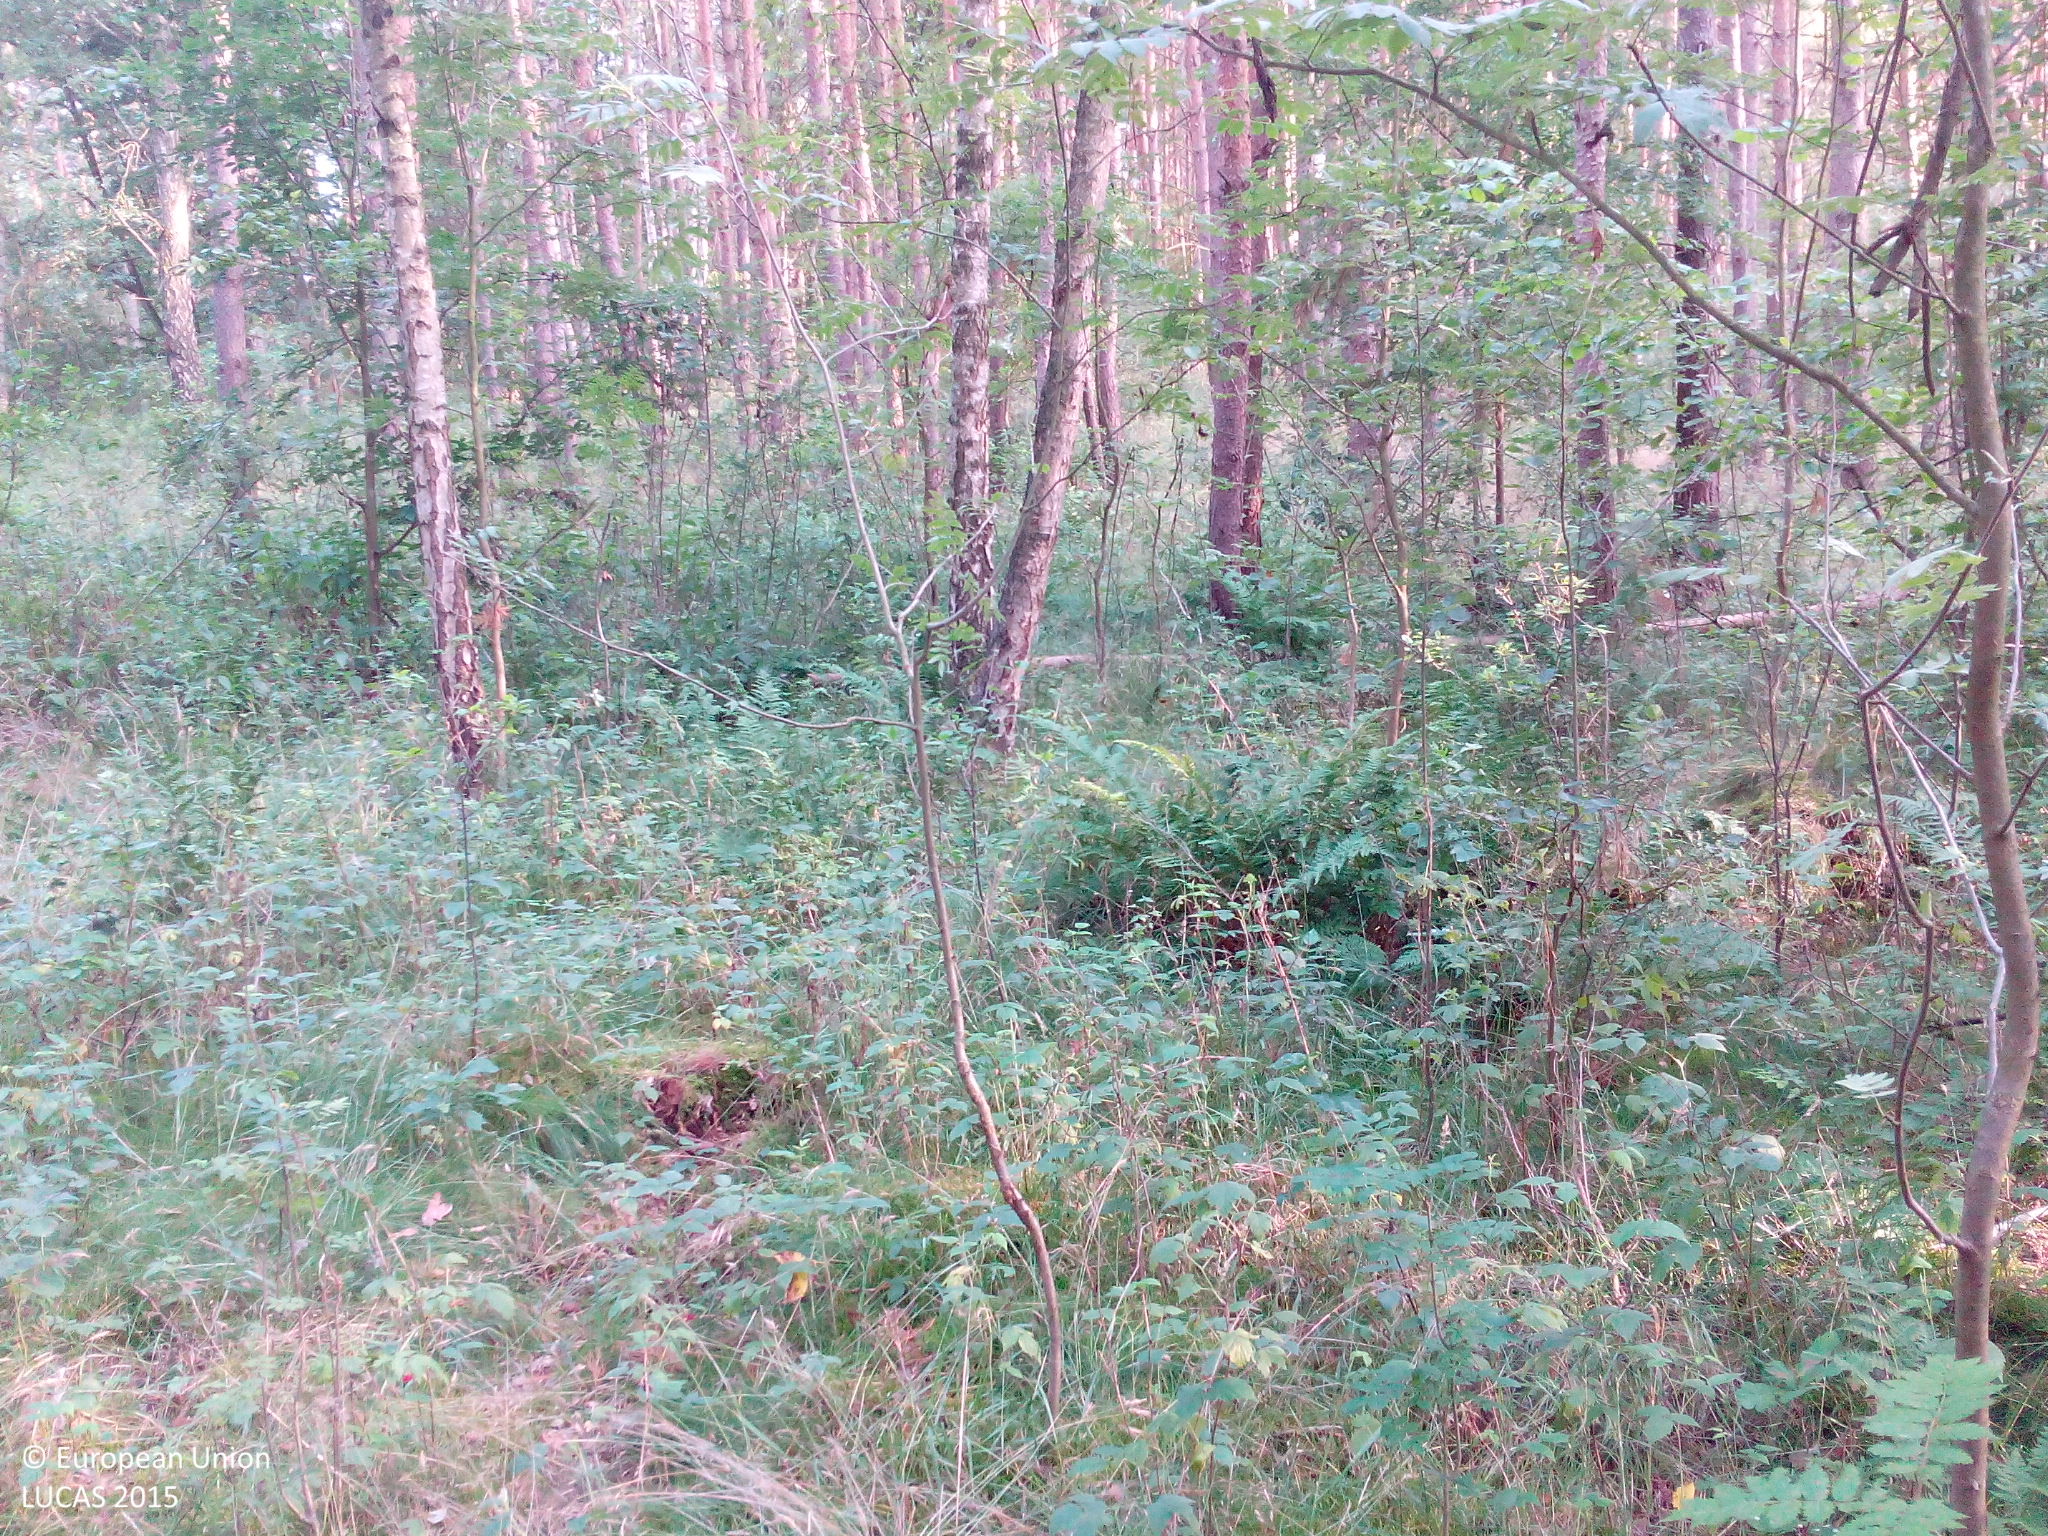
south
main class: Woodland
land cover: Pine dominated mixed woodland
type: hemiboreal forest and nemoral coniferous forest and mixed broadleaved-coniferous forest
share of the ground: 50 - 75 %
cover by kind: coniferous forest trees 45 %, broadleaved forest trees 25 %, shrubs 15 %, herbaceous plants 15 %
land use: Forestry
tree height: > 5 m
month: July
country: DE
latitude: 53.4878
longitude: 14.2960
